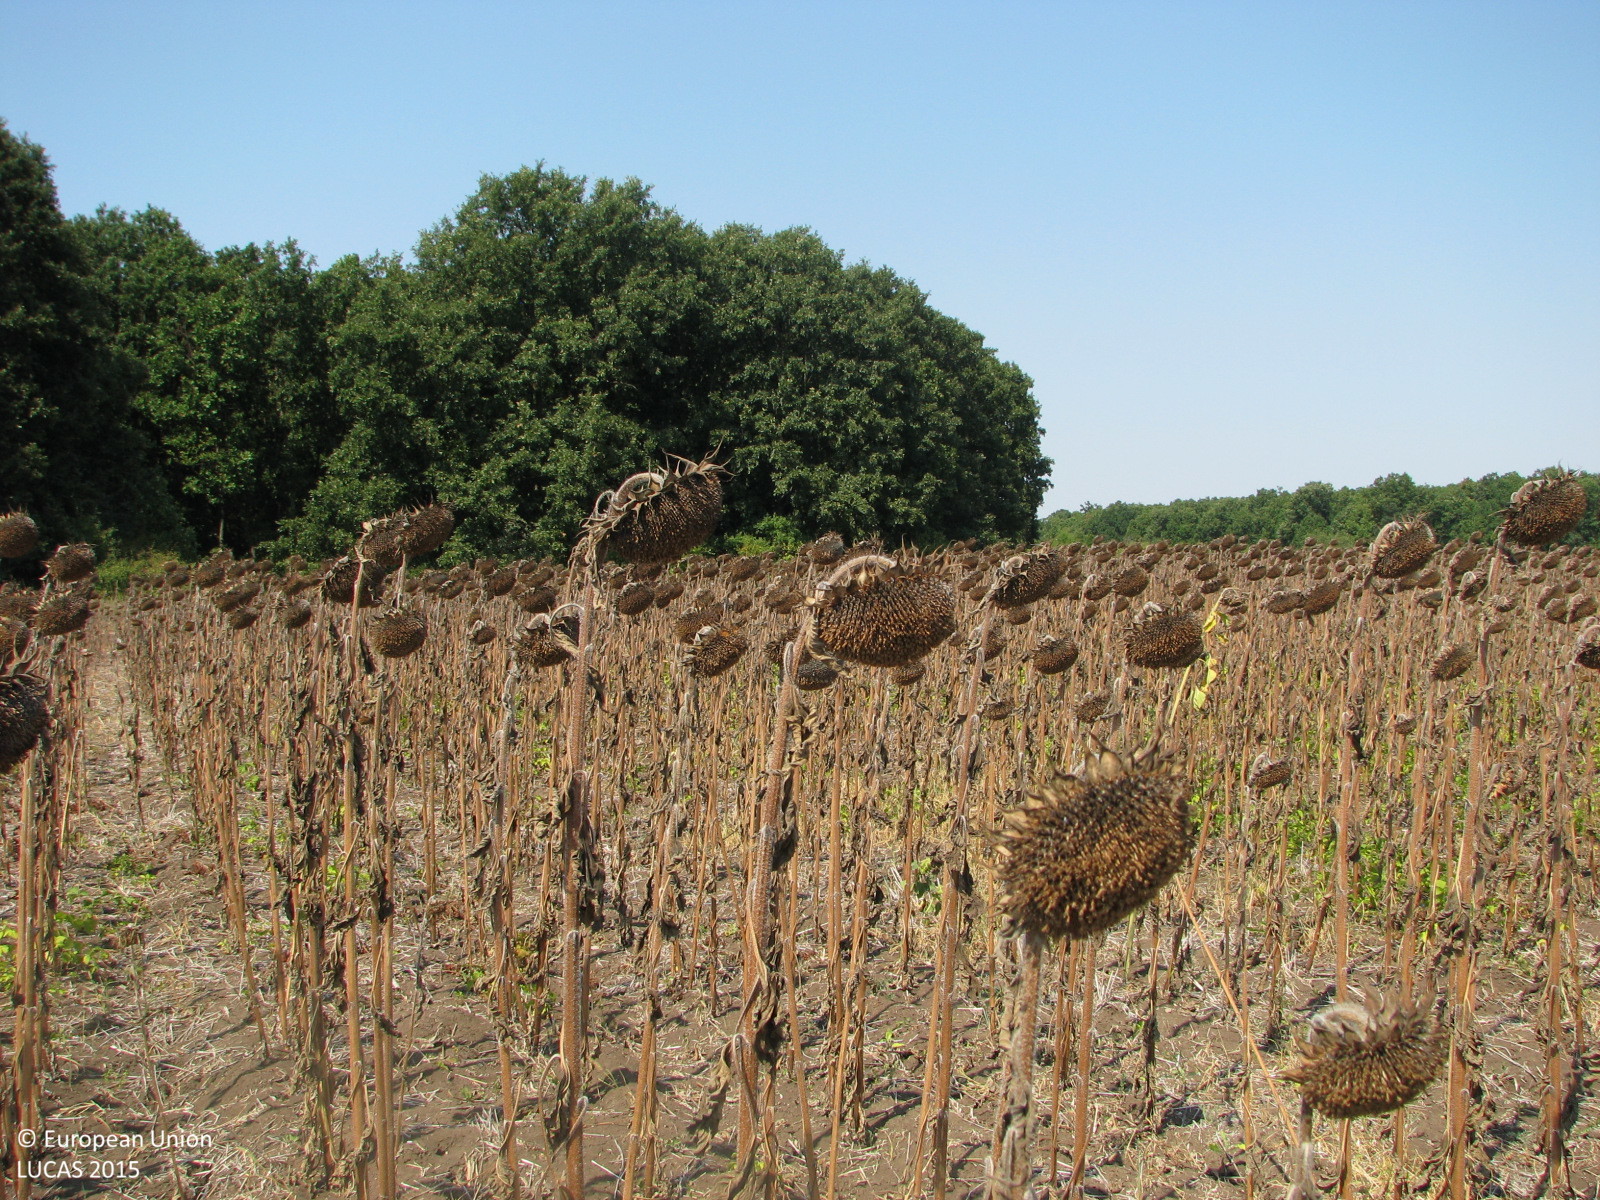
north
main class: Cropland
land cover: Sunflower
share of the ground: 50 - 75 %
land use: Agriculture (excluding fallow land and kitchen gardens)
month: September
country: BG
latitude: 42.4020
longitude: 26.7792
